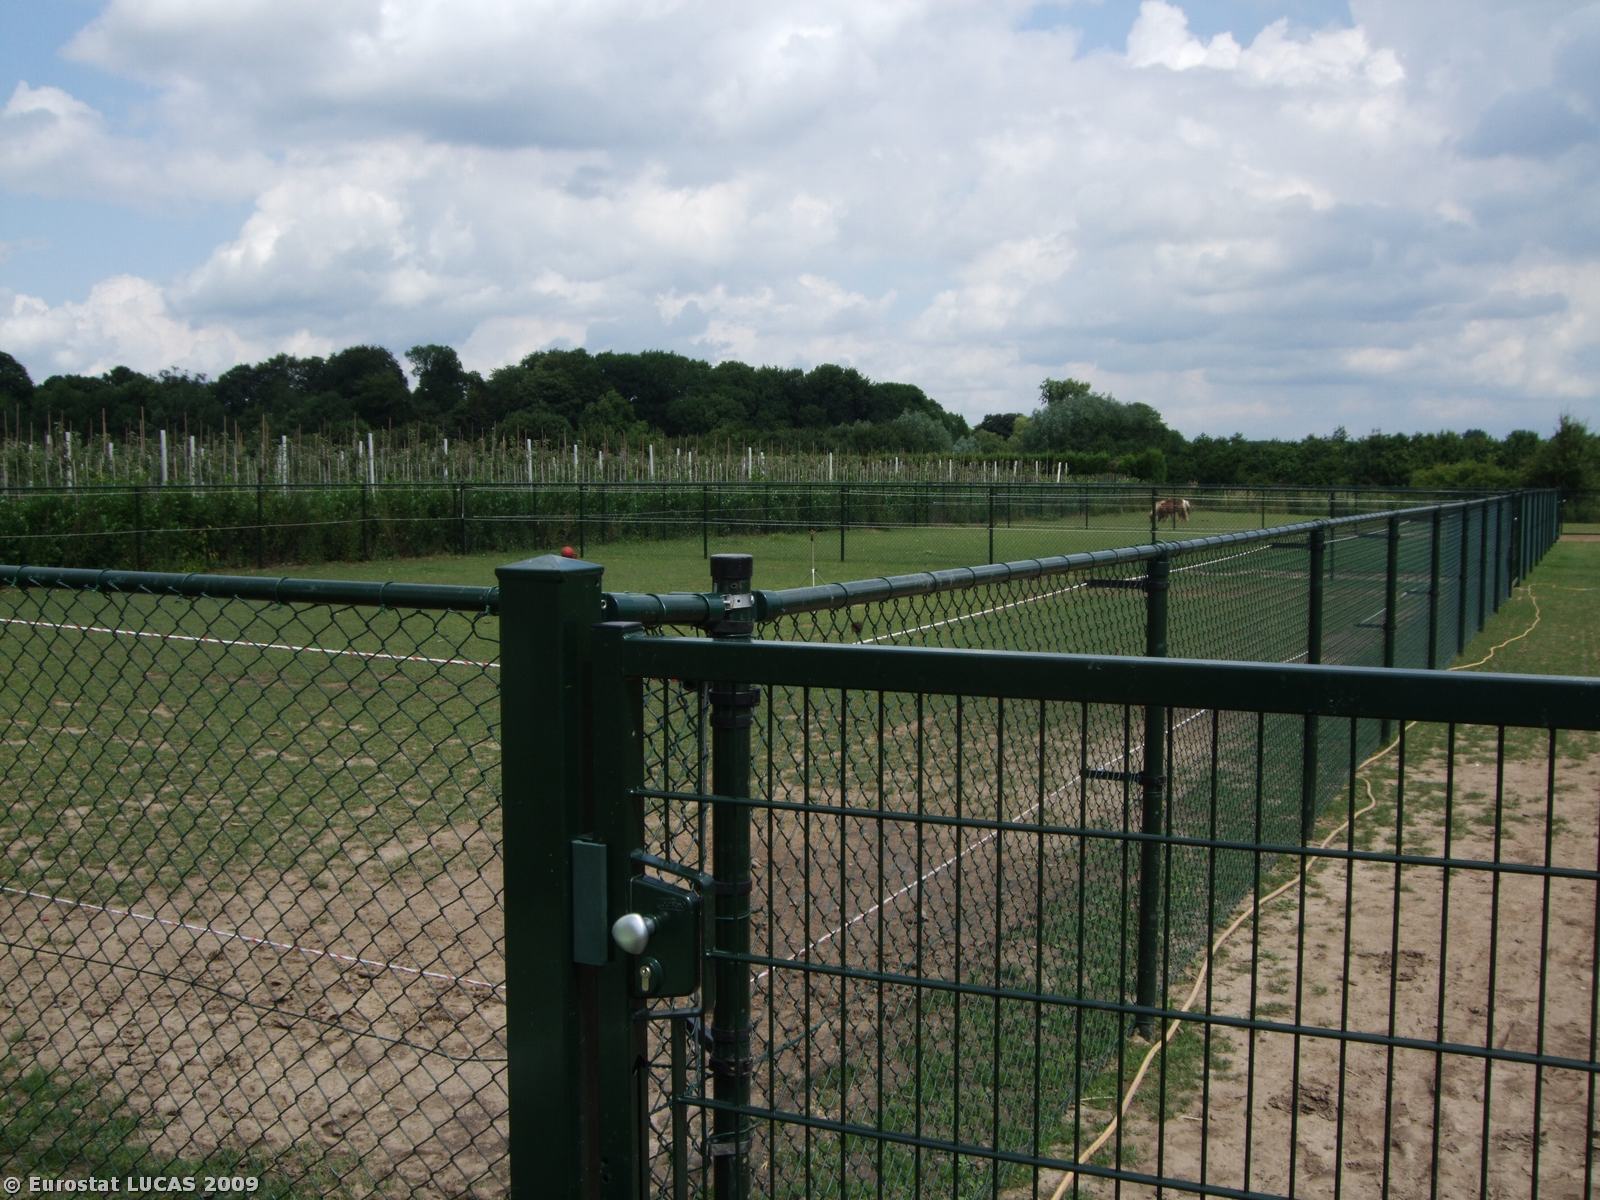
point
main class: Cropland
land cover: Apple fruit
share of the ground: 25 - 50 %
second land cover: Grassland with sparse tree/shrub cover
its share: 50 - 75 %
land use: Agriculture (excluding fallow land and kitchen gardens)
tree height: < 5 m
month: July
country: NL
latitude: 51.9110
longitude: 5.4190
